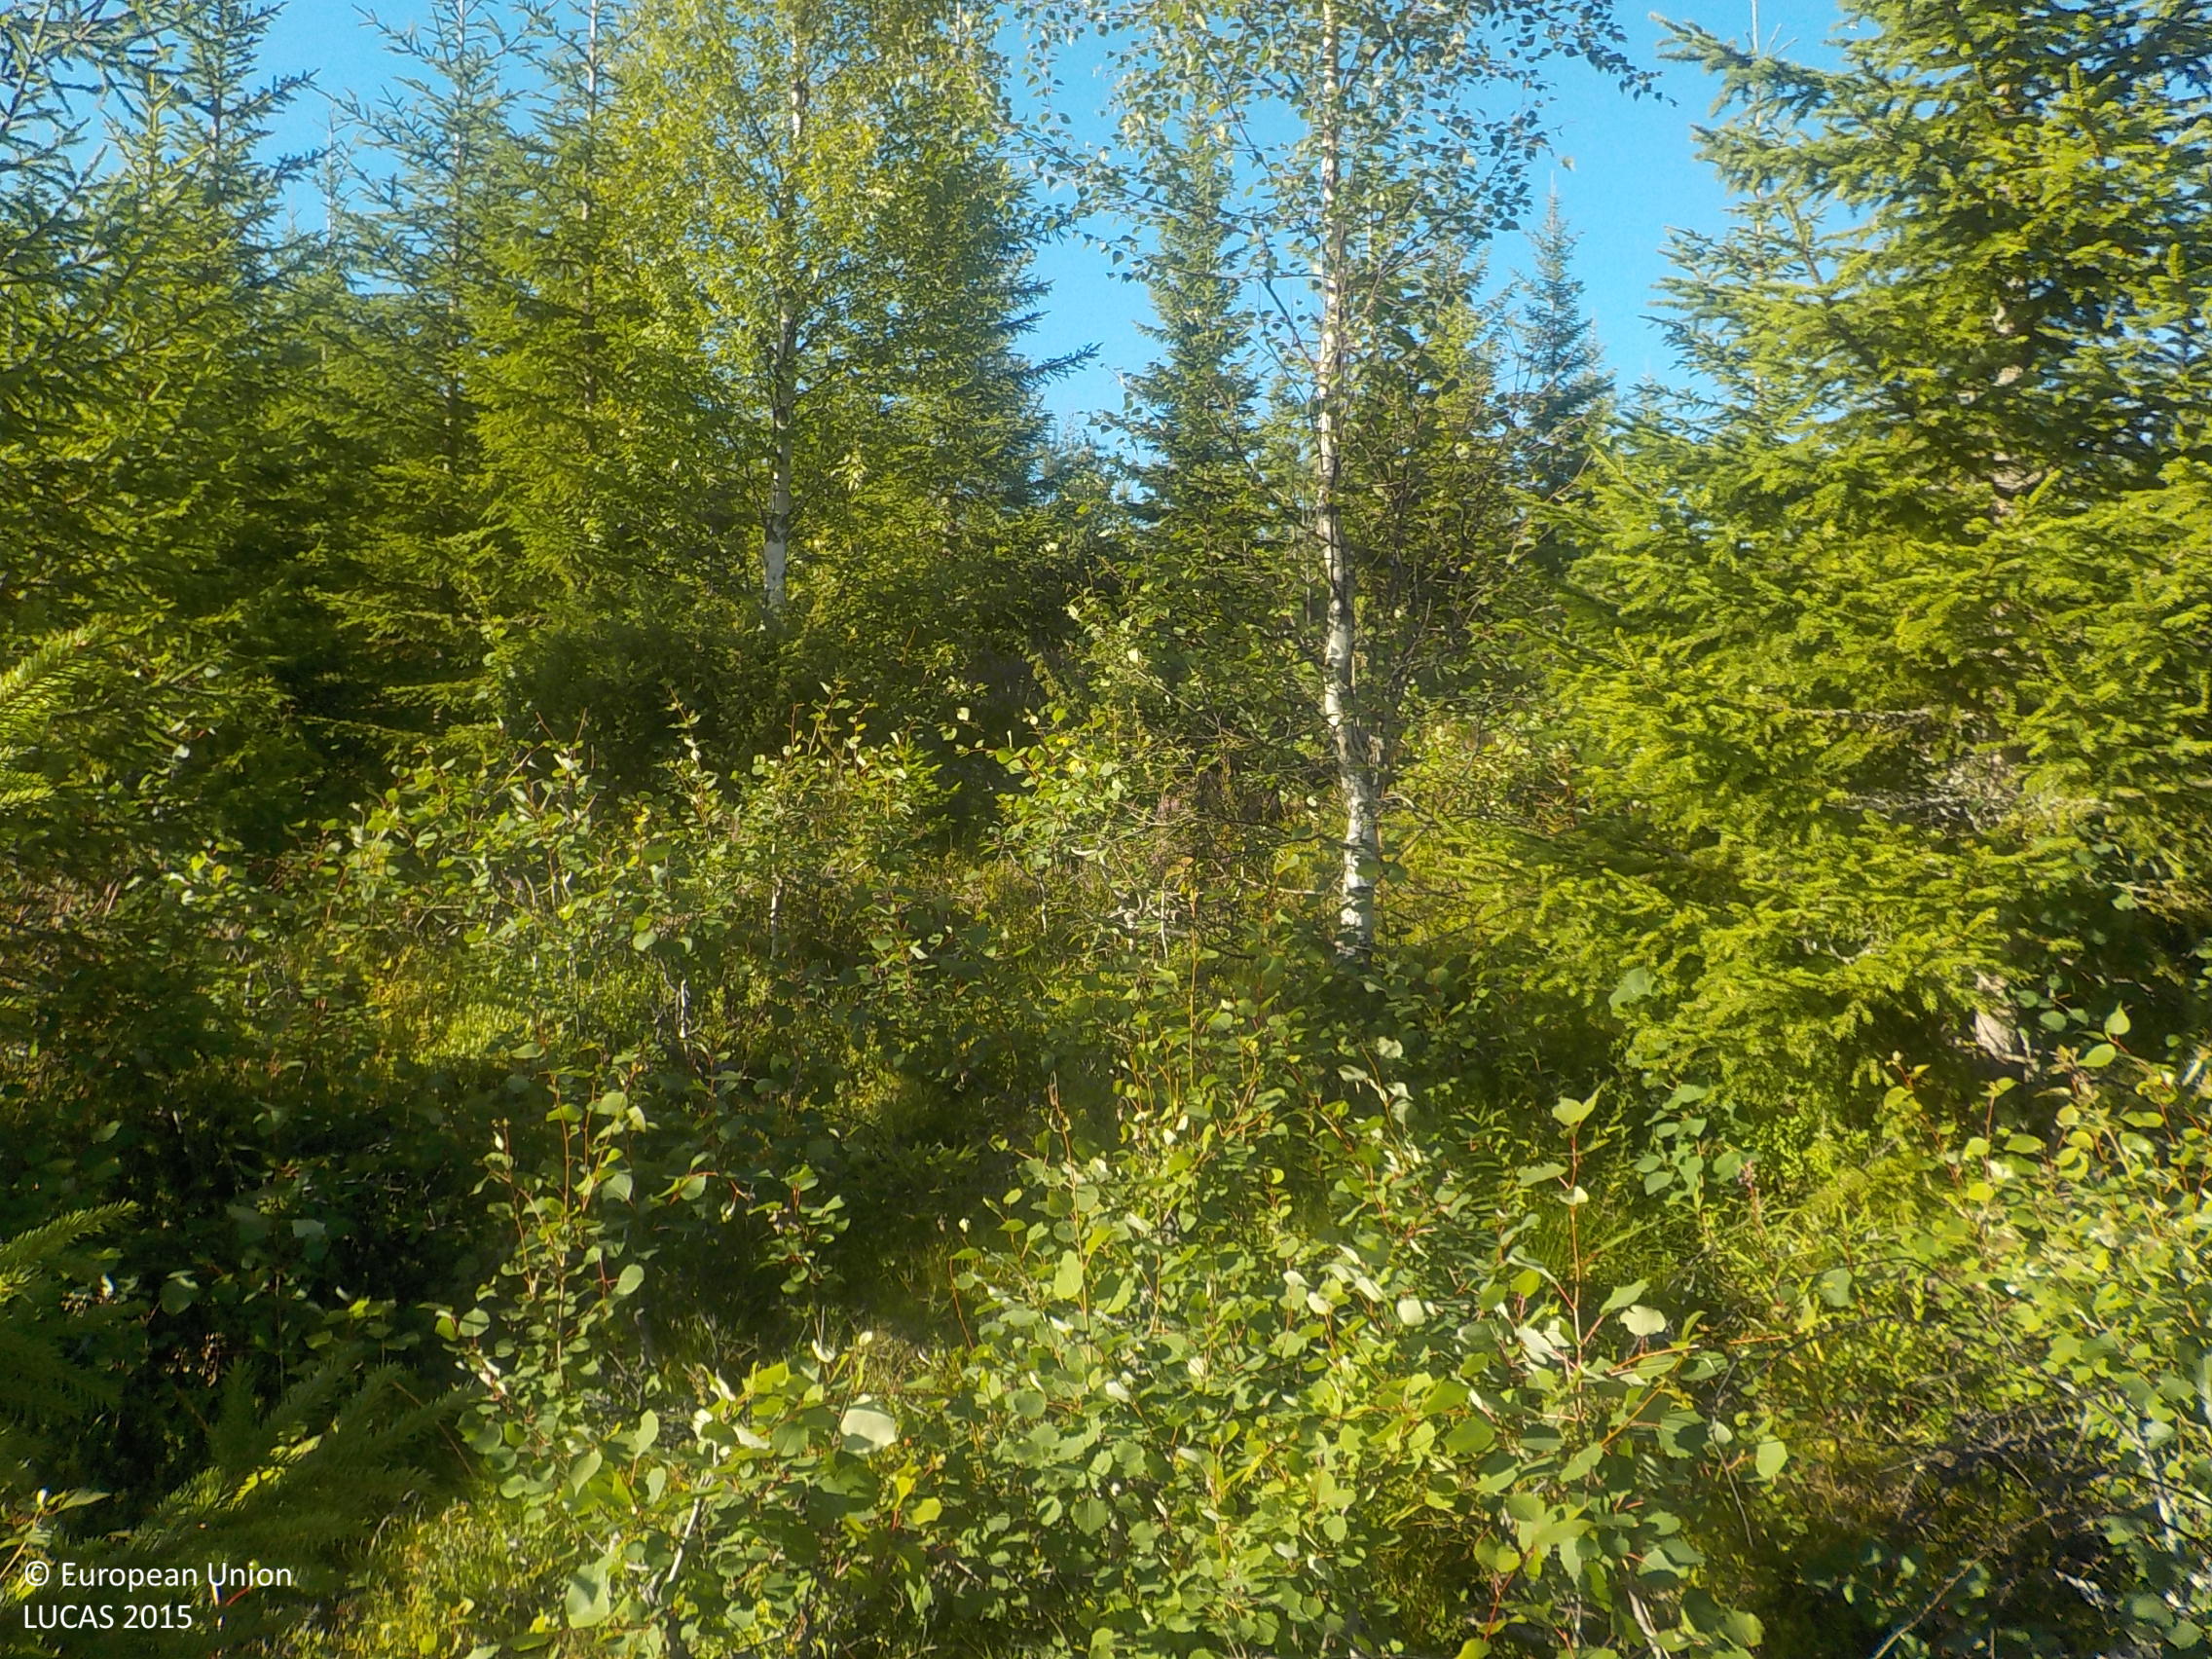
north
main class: Woodland
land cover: Spruce dominated mixed woodland
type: boreal forest
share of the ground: 50 - 75 %
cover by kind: coniferous forest trees 45 %, shrubs 25 %, broadleaved forest trees 20 %, herbaceous plants 10 %
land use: Forestry
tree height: < 5 m
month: August
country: SE
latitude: 63.6657
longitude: 18.0759
